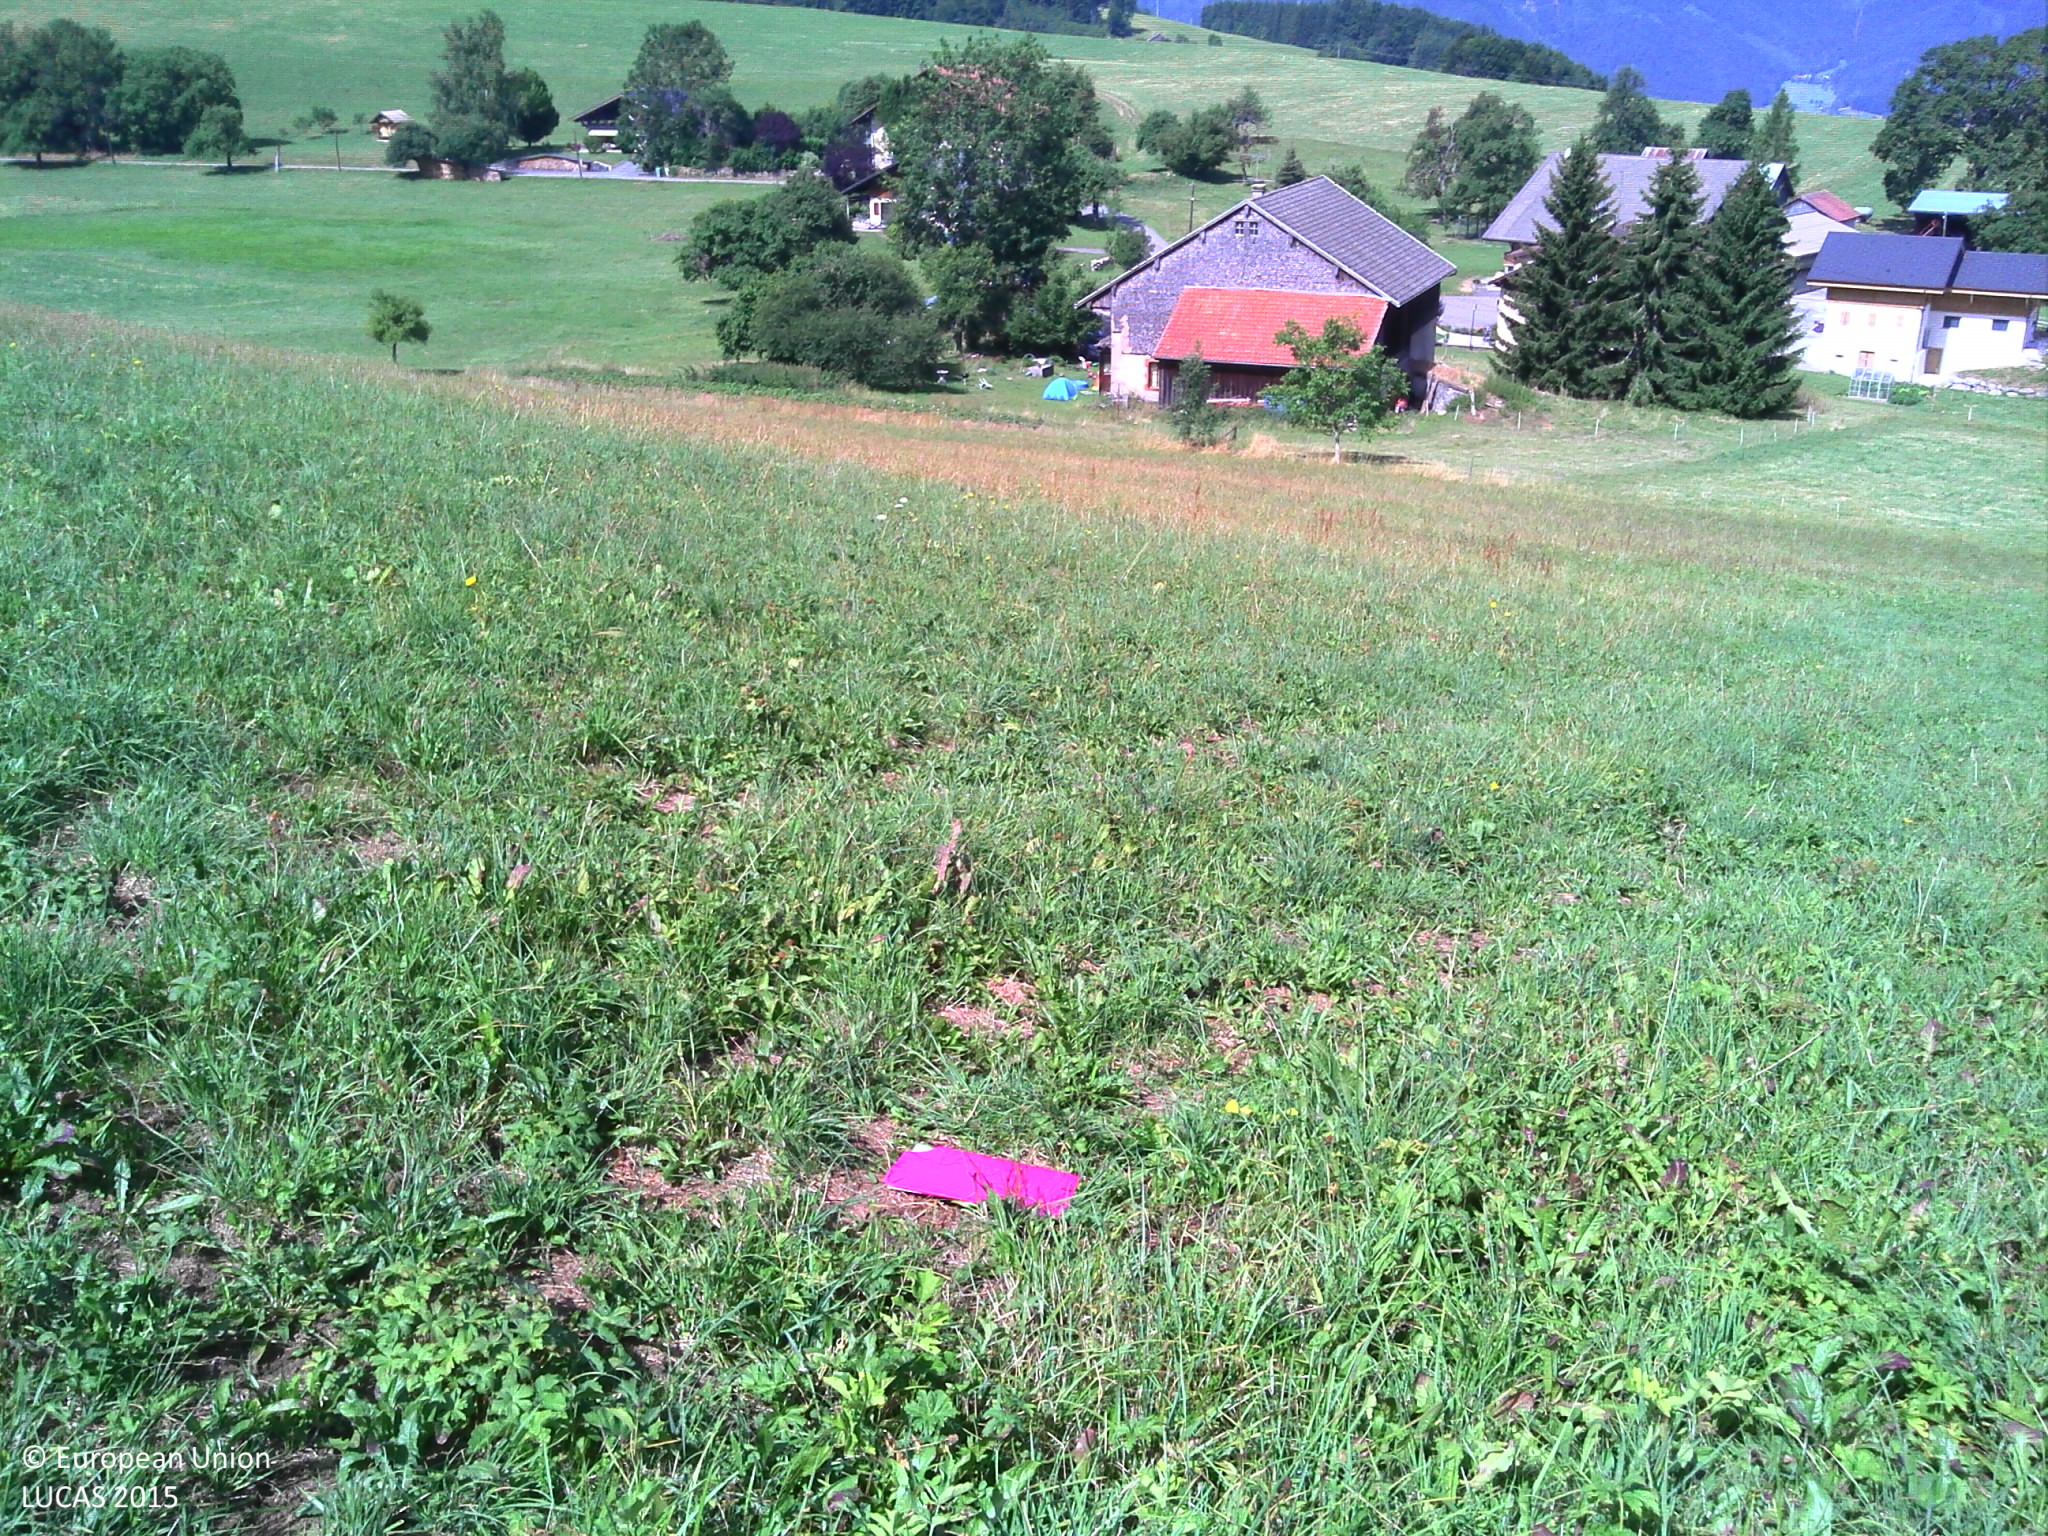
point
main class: Grassland
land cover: Grassland without tree/shrub cover
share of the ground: > 75 %
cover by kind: herbaceous plants 100 %
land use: Agriculture (excluding fallow land and kitchen gardens)
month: July
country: FR
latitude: 46.2018
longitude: 6.4396
